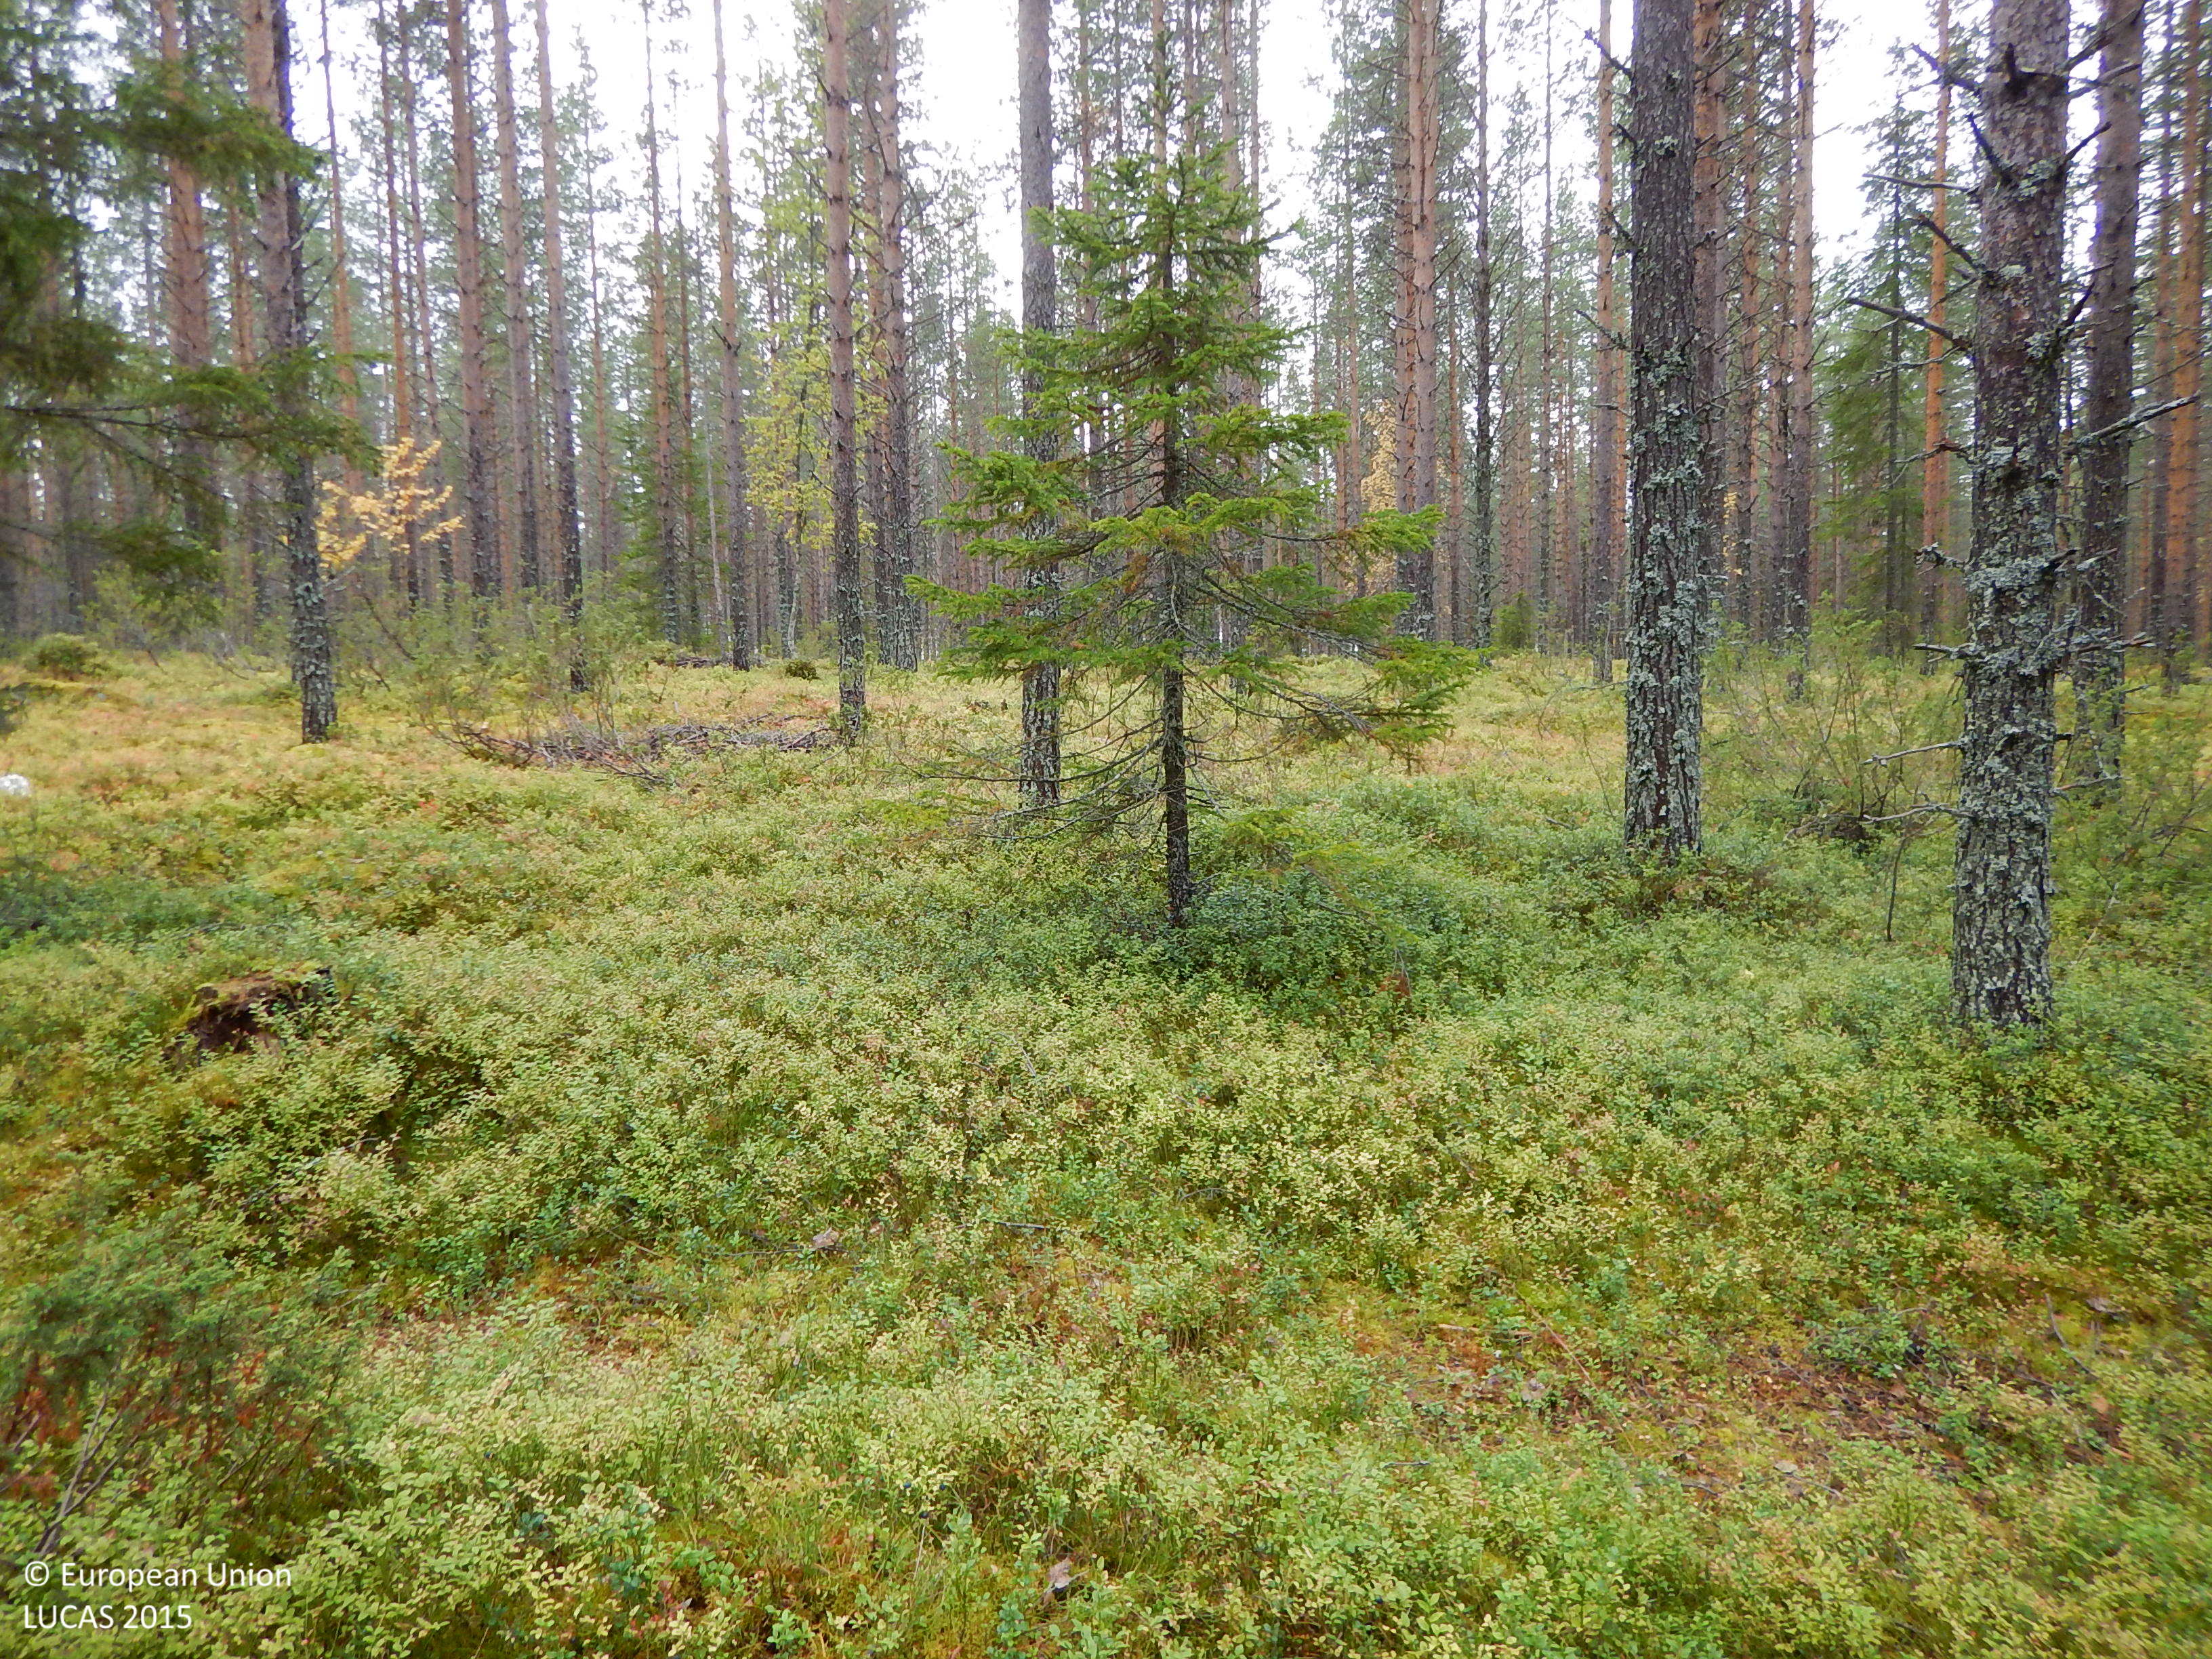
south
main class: Woodland
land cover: Pine dominated coniferous woodland
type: boreal forest
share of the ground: 50 - 75 %
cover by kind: coniferous forest trees 50 %, shrubs 35 %, lichens and mosses 15 %
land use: Forestry
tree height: > 5 m
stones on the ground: < 10 %
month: September
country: SE
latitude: 65.1420
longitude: 19.0252
